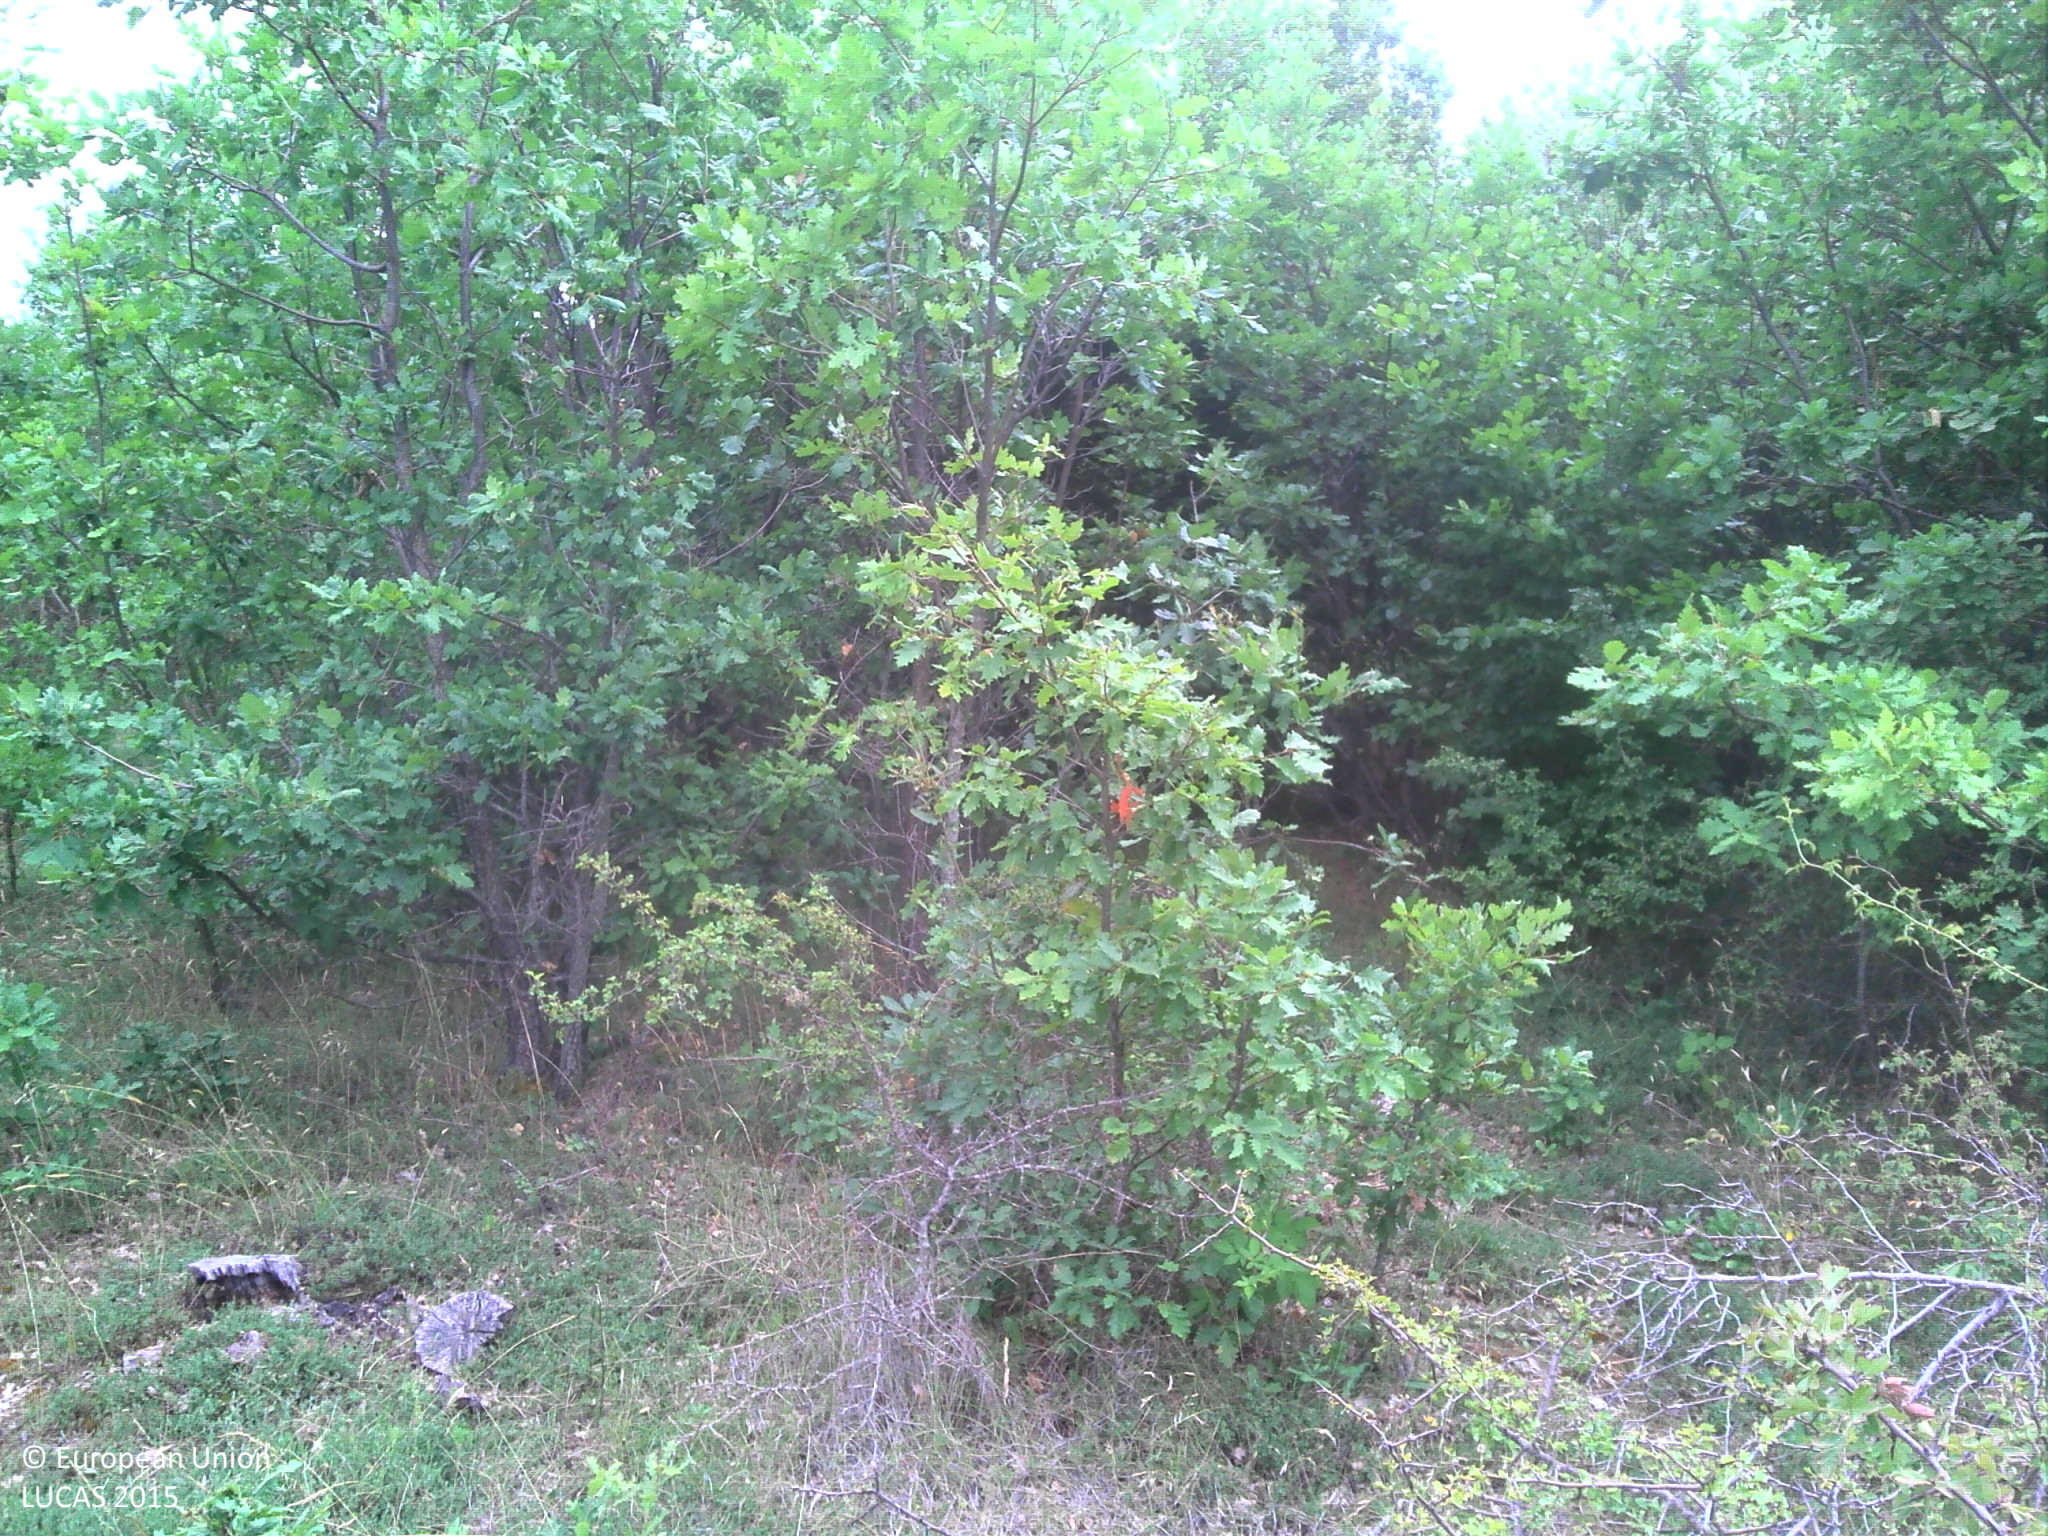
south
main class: Woodland
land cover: Broadleaved woodland
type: thermophilous deciduous forest
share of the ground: 50 - 75 %
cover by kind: broadleaved forest trees 65 %, shrubs 20 %, herbaceous plants 10 %, consolidated bare surface 5 %
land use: Forestry
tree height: > 5 m
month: July
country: FR
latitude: 44.0576
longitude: 5.5767
